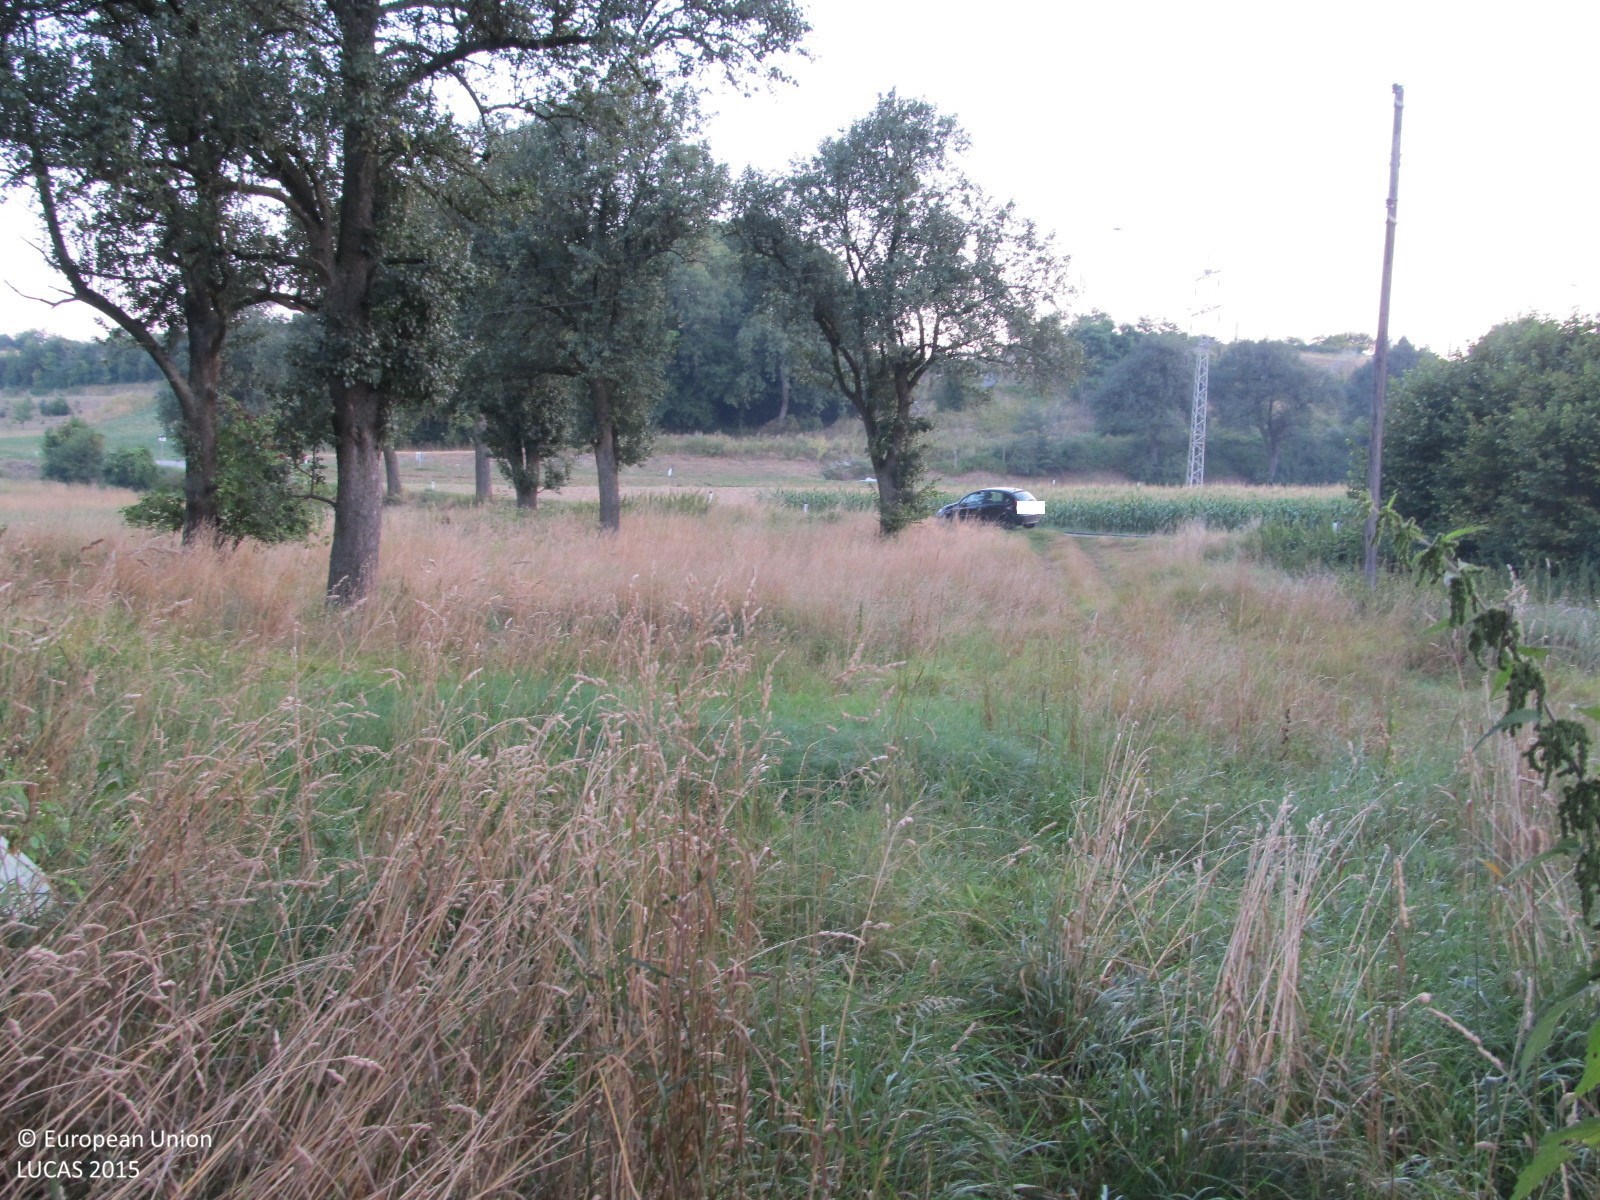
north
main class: Cropland
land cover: Common wheat
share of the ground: > 75 %
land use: Agriculture (excluding fallow land and kitchen gardens)
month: August
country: AT
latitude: 48.1736
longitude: 15.5563
